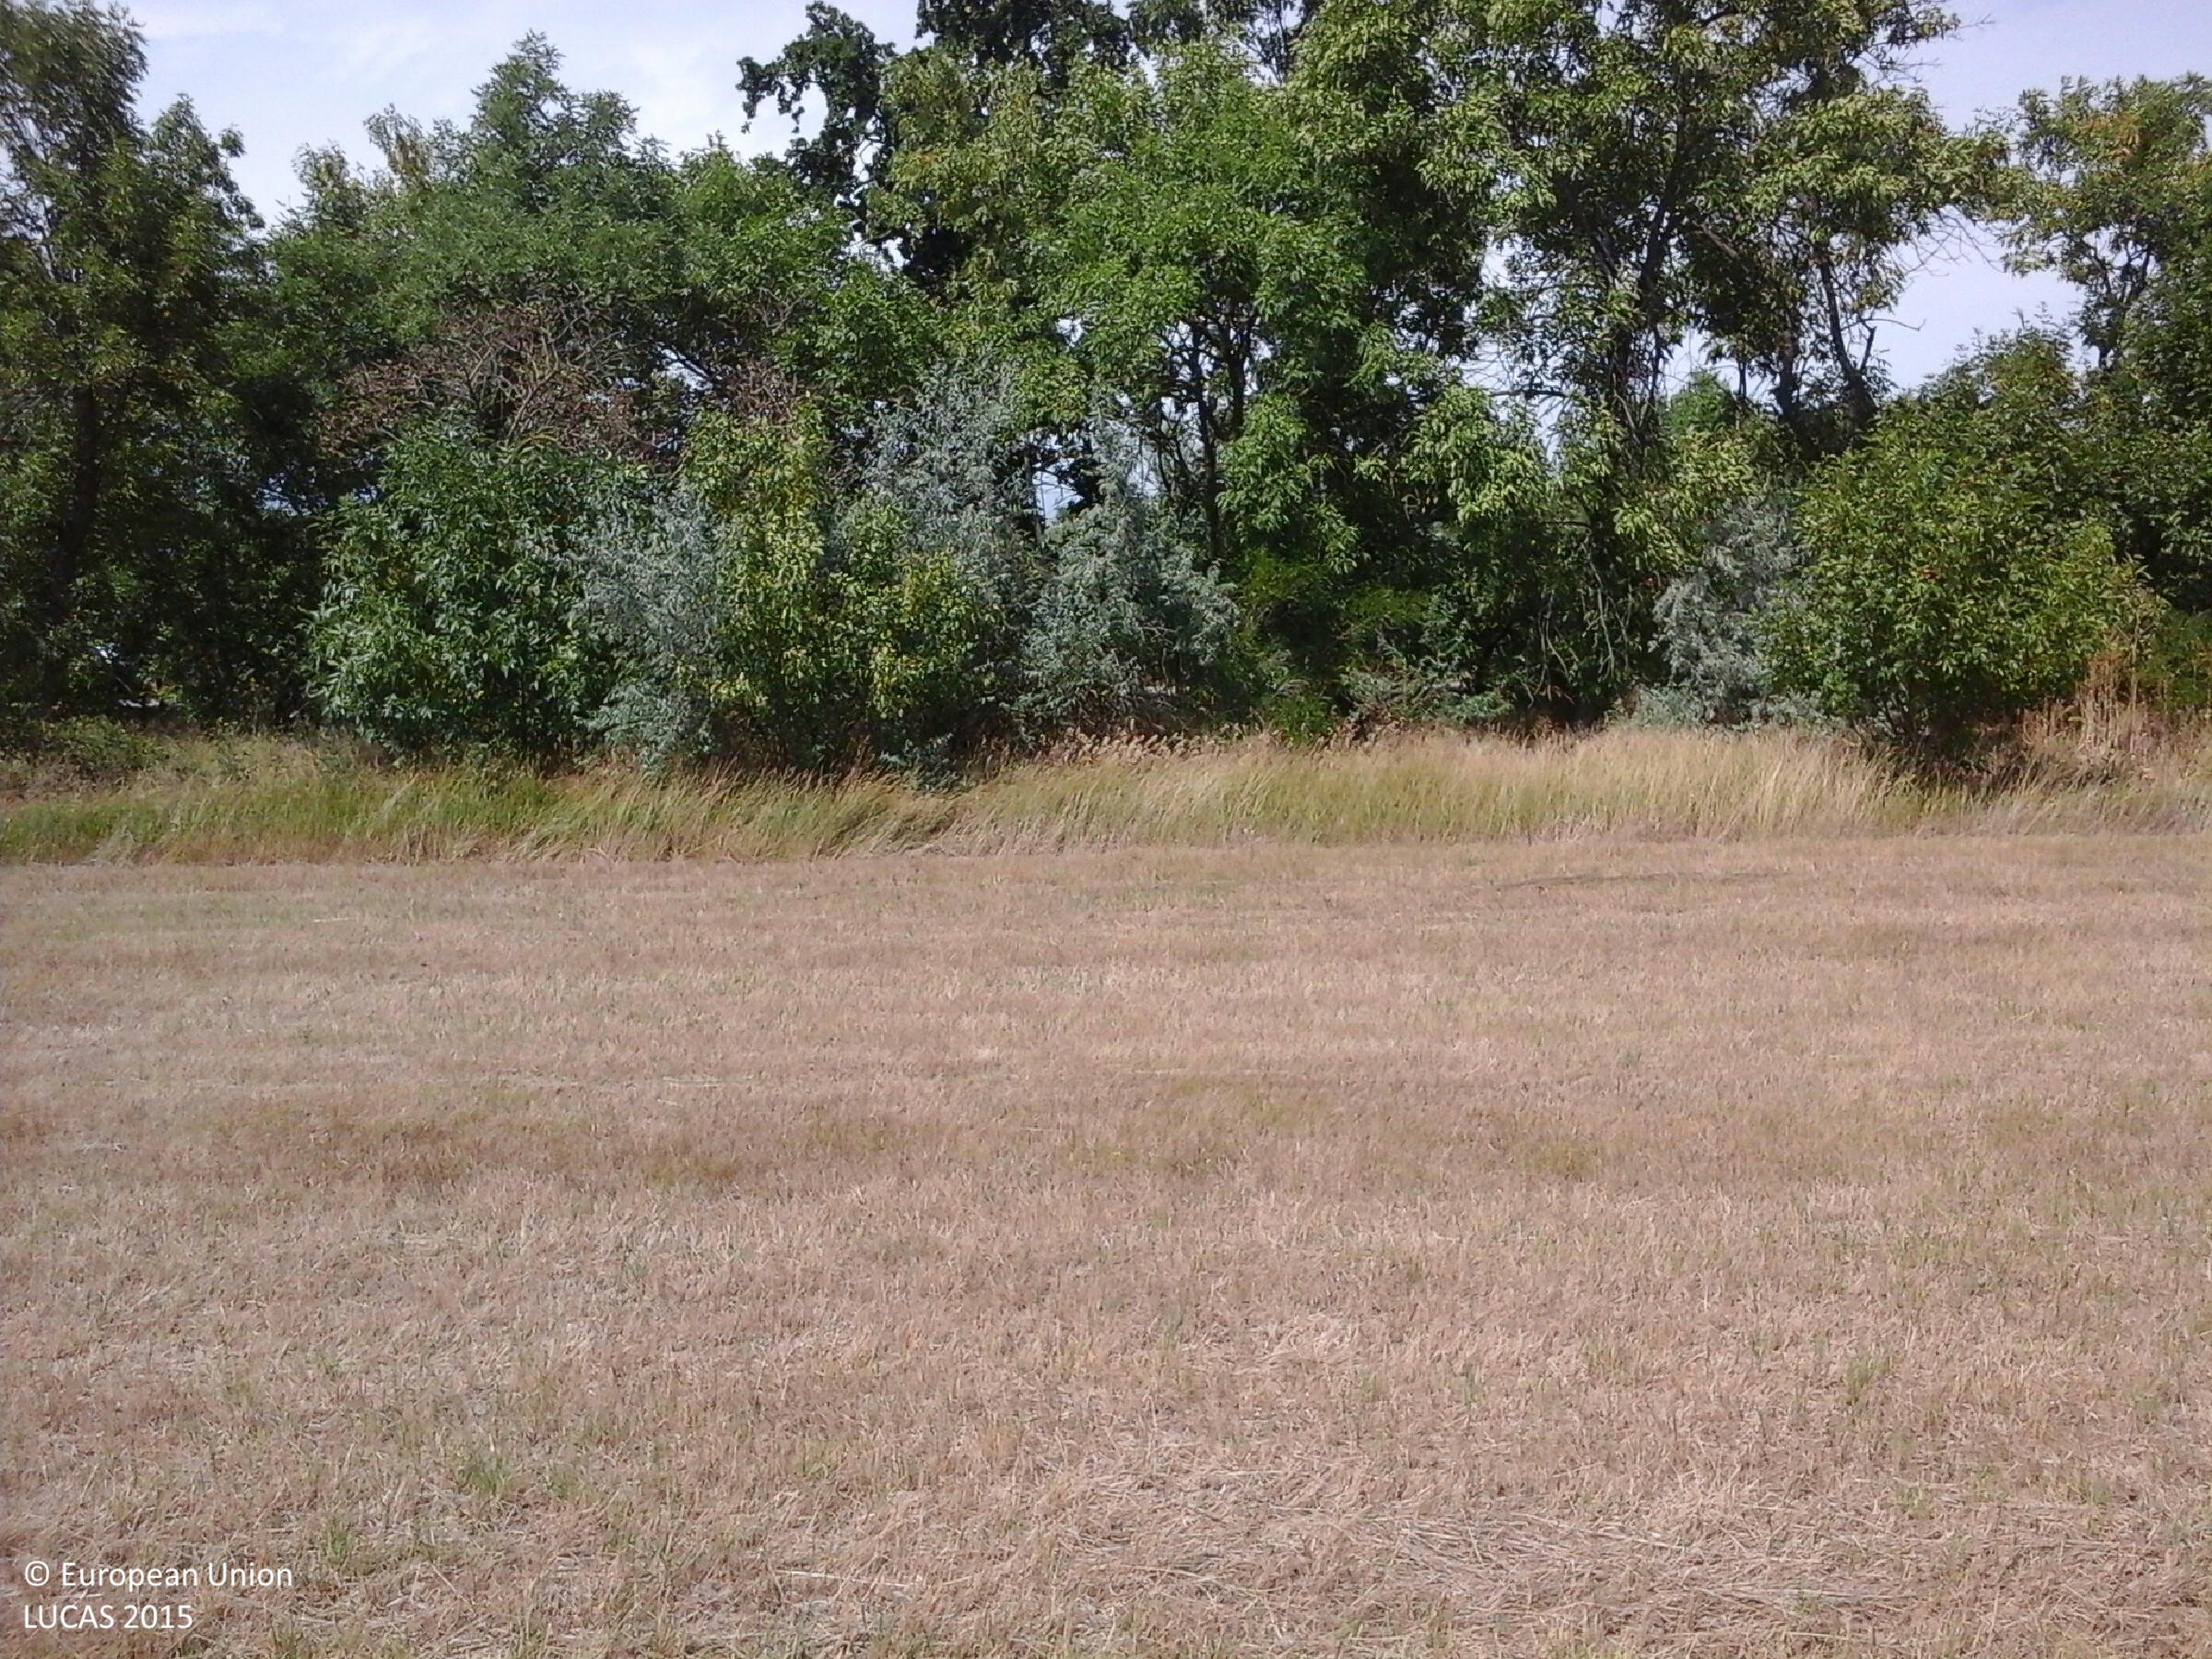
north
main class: Grassland
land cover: Grassland without tree/shrub cover
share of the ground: > 75 %
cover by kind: herbaceous plants 100 %
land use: Agriculture (excluding fallow land and kitchen gardens)
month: July
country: HU
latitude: 47.4566
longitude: 20.6036
